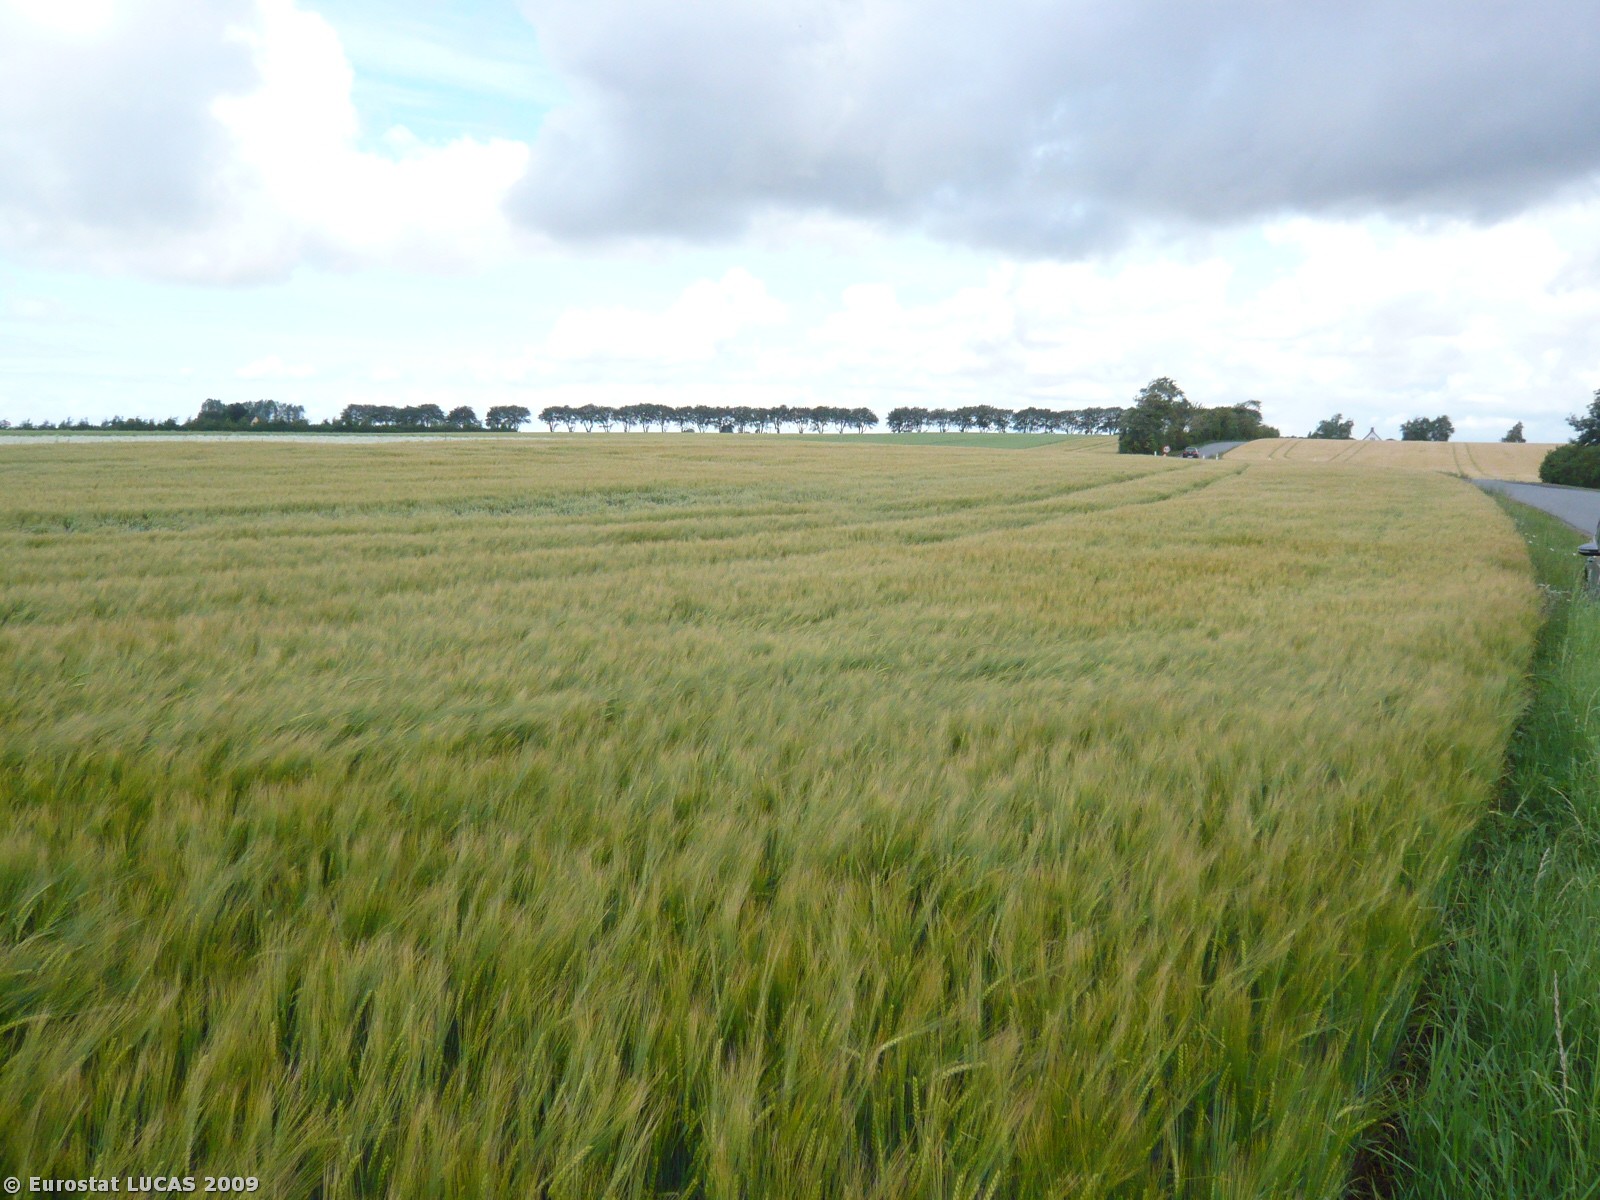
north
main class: Cropland
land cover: Barley
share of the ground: > 75 %
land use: Agriculture (excluding fallow land and kitchen gardens)
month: July
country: DK
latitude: 55.3904
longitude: 11.2776
